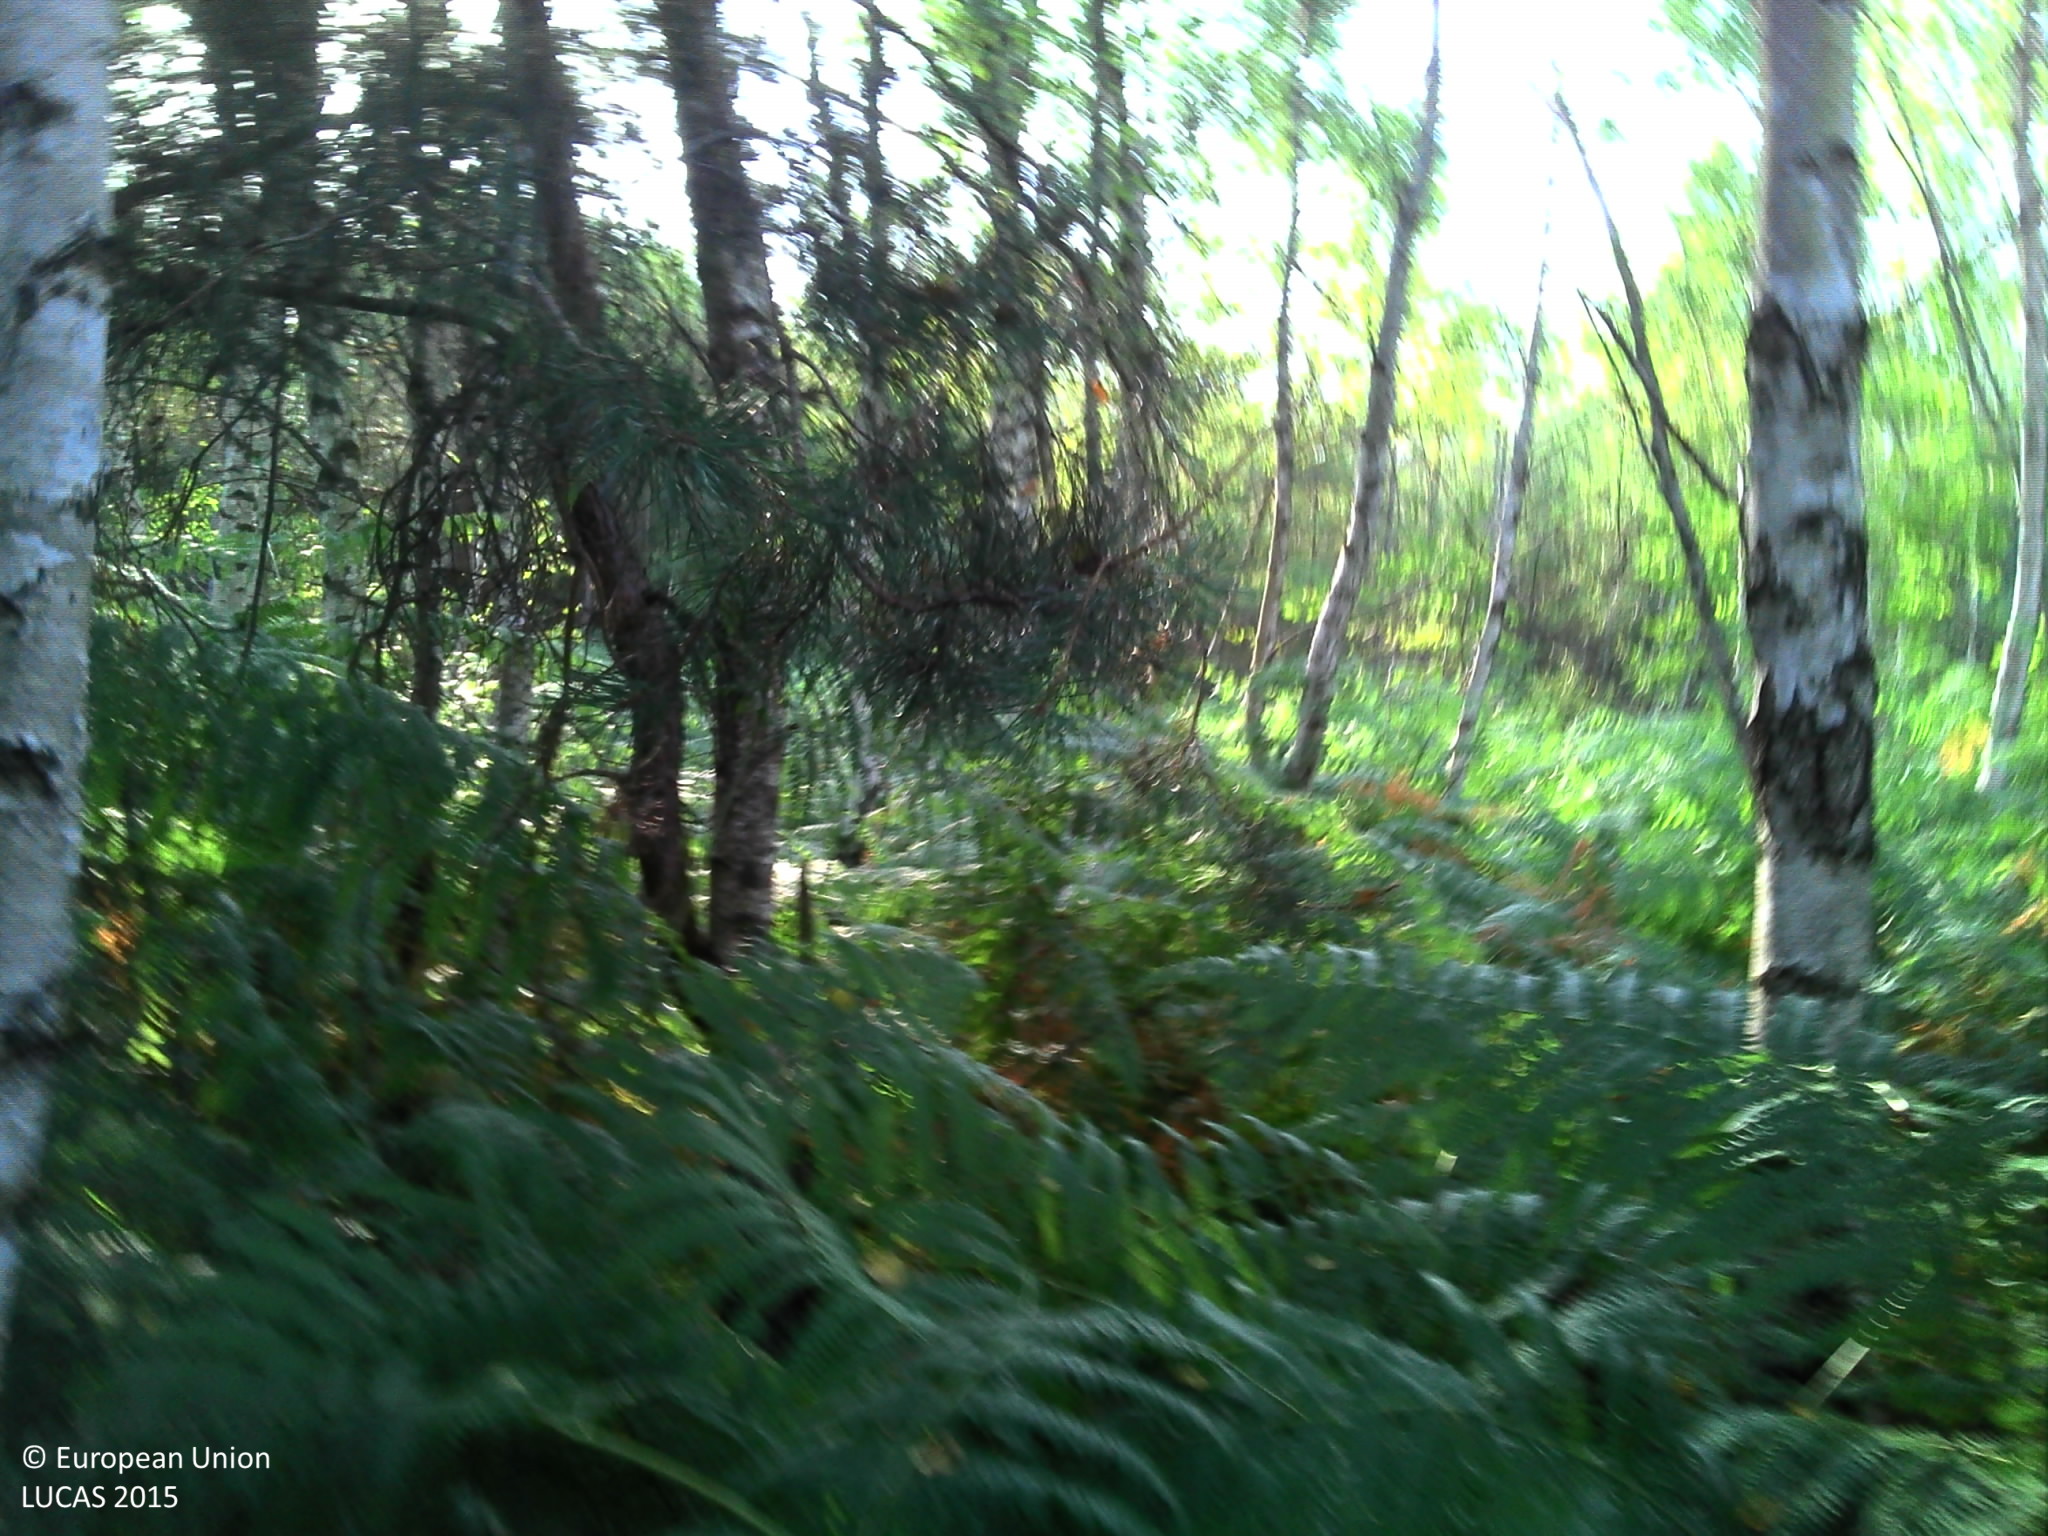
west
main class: Woodland
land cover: Pine dominated mixed woodland
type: acidophilous oak and oak-birch forest
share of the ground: > 75 %
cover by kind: herbaceous plants 60 %, broadleaved forest trees 30 %, coniferous forest trees 10 %
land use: Forestry
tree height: > 5 m
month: August
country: FR
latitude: 47.2924
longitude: 2.1493
